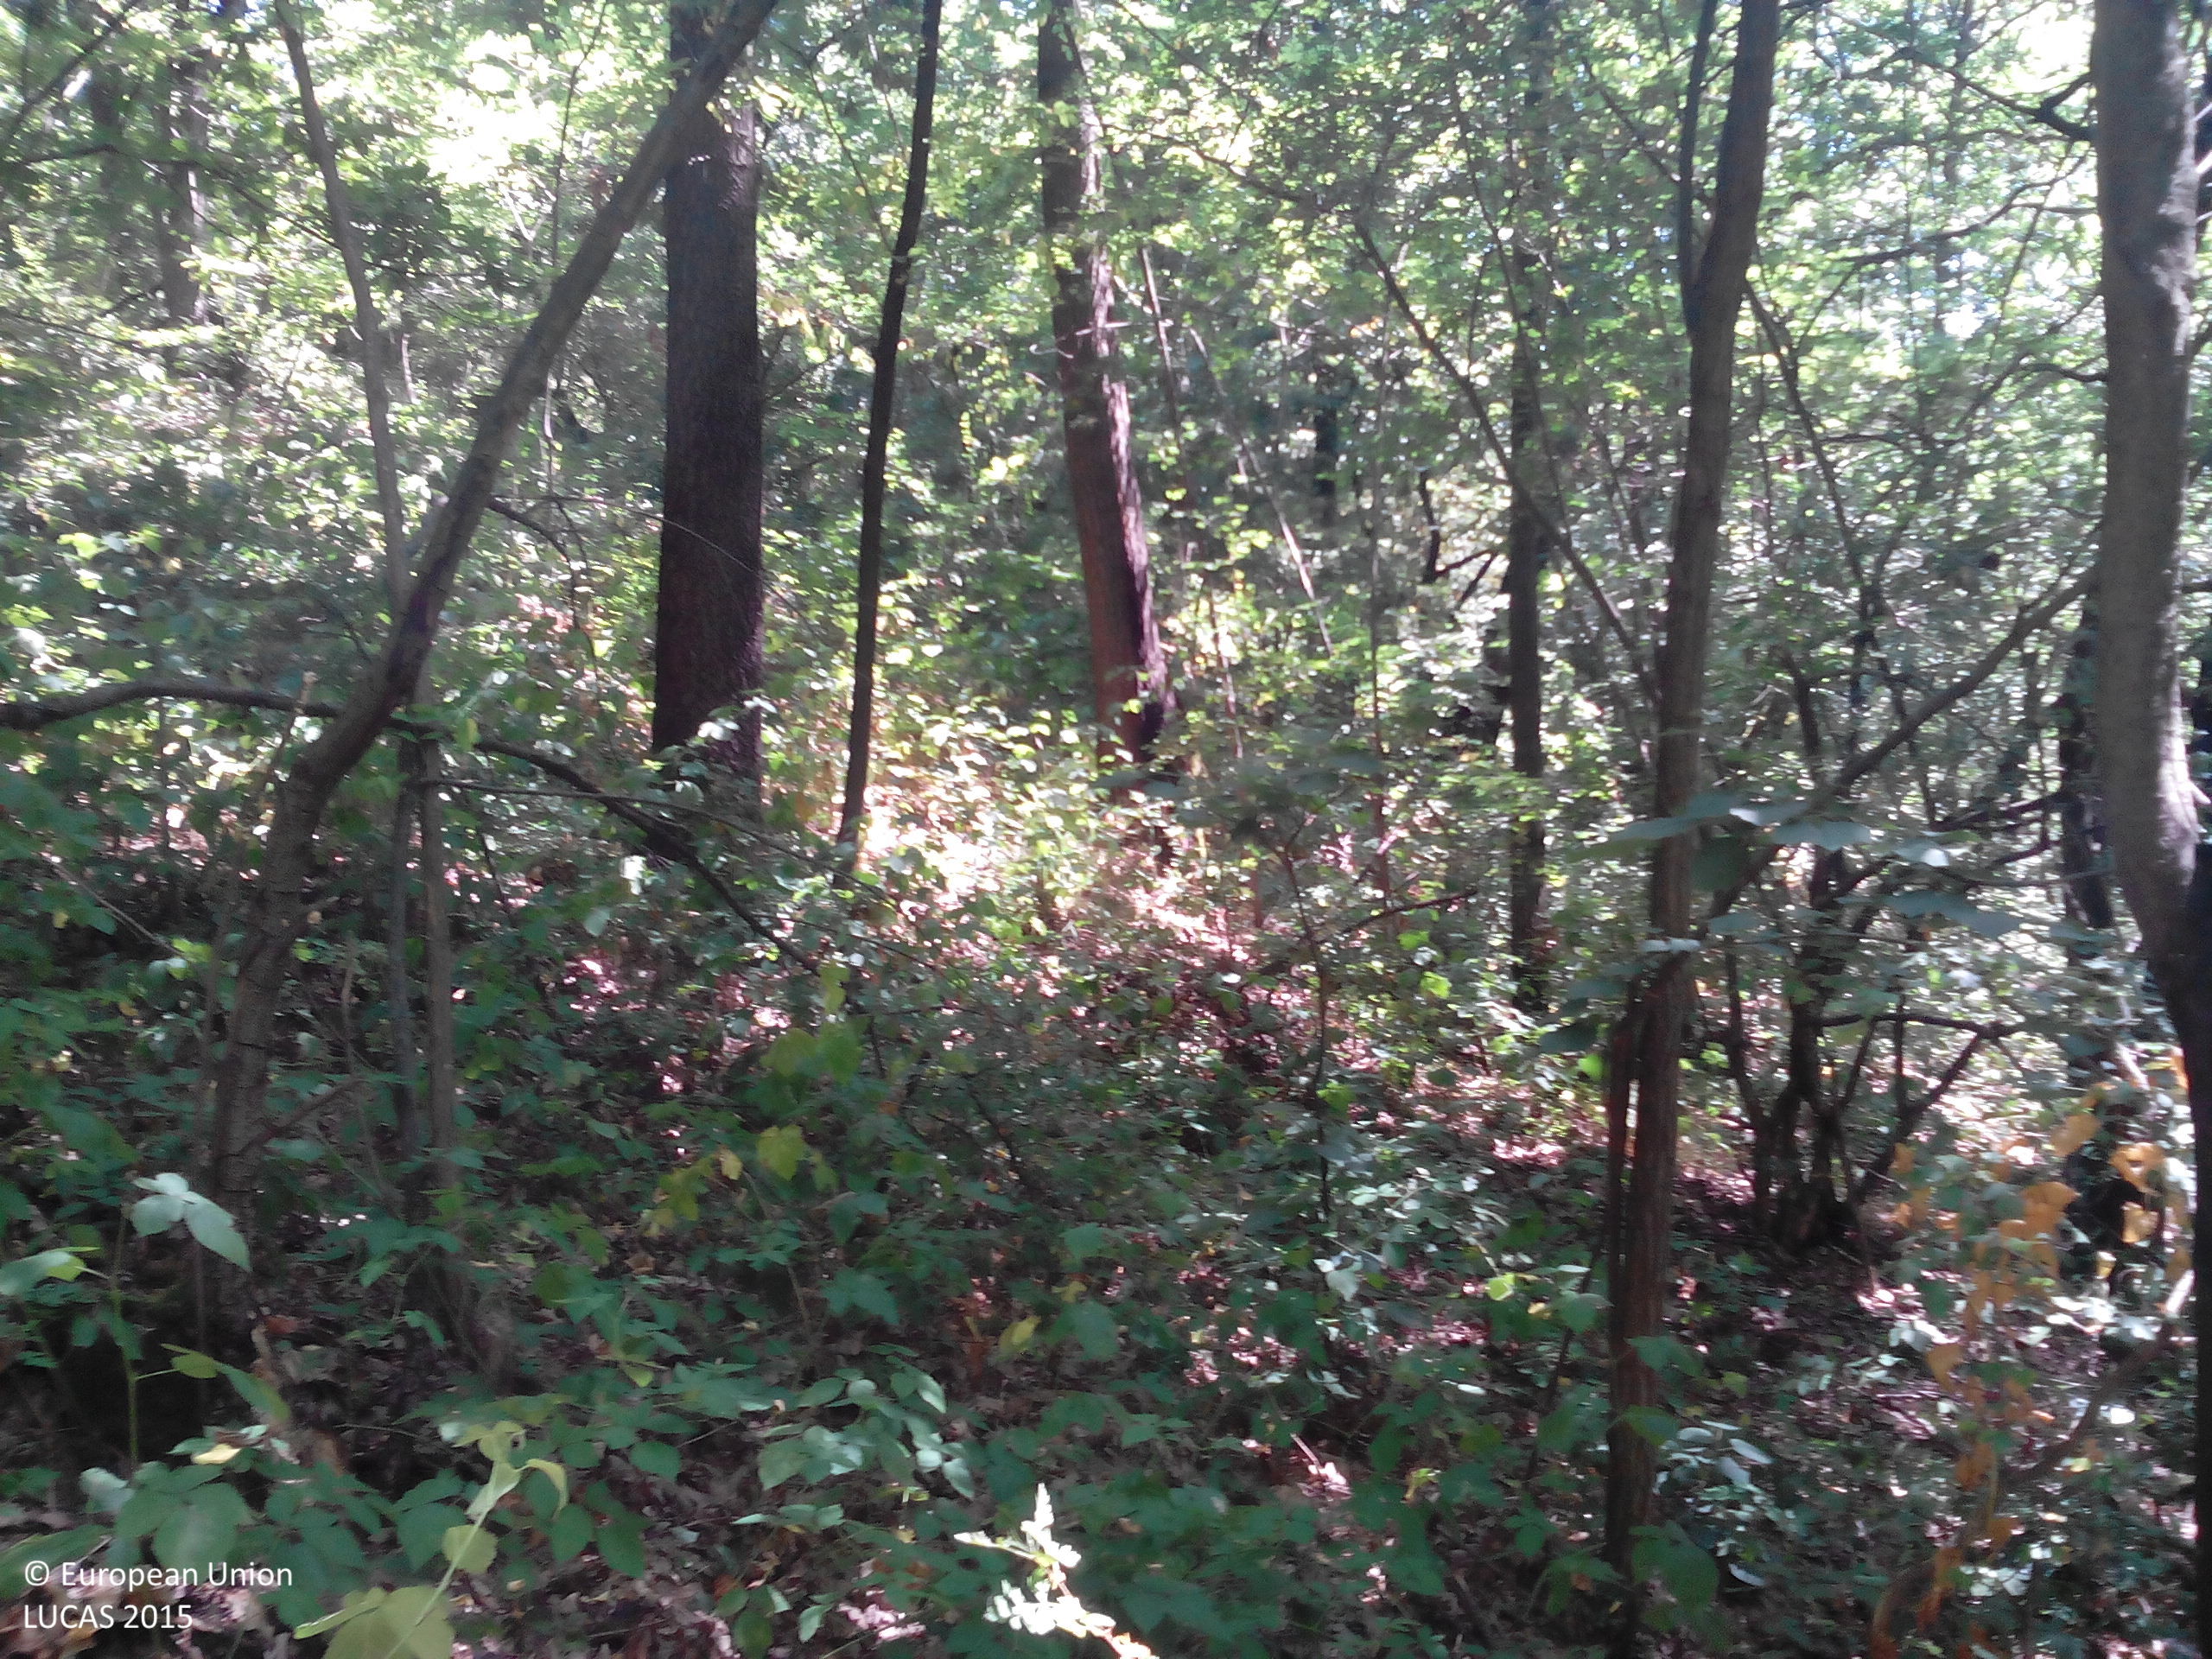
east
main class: Woodland
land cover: Broadleaved woodland
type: mesophytic deciduous forest
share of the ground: > 75 %
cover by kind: broadleaved forest trees 90 %, shrubs 5 %, herbaceous plants 5 %
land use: Forestry
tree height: > 5 m
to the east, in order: Broadleaved woodland; Rivers and streams; Broadleaved woodland; Rivers and streams; Broadleaved woodland
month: August
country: BG
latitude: 43.1891
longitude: 23.6404
